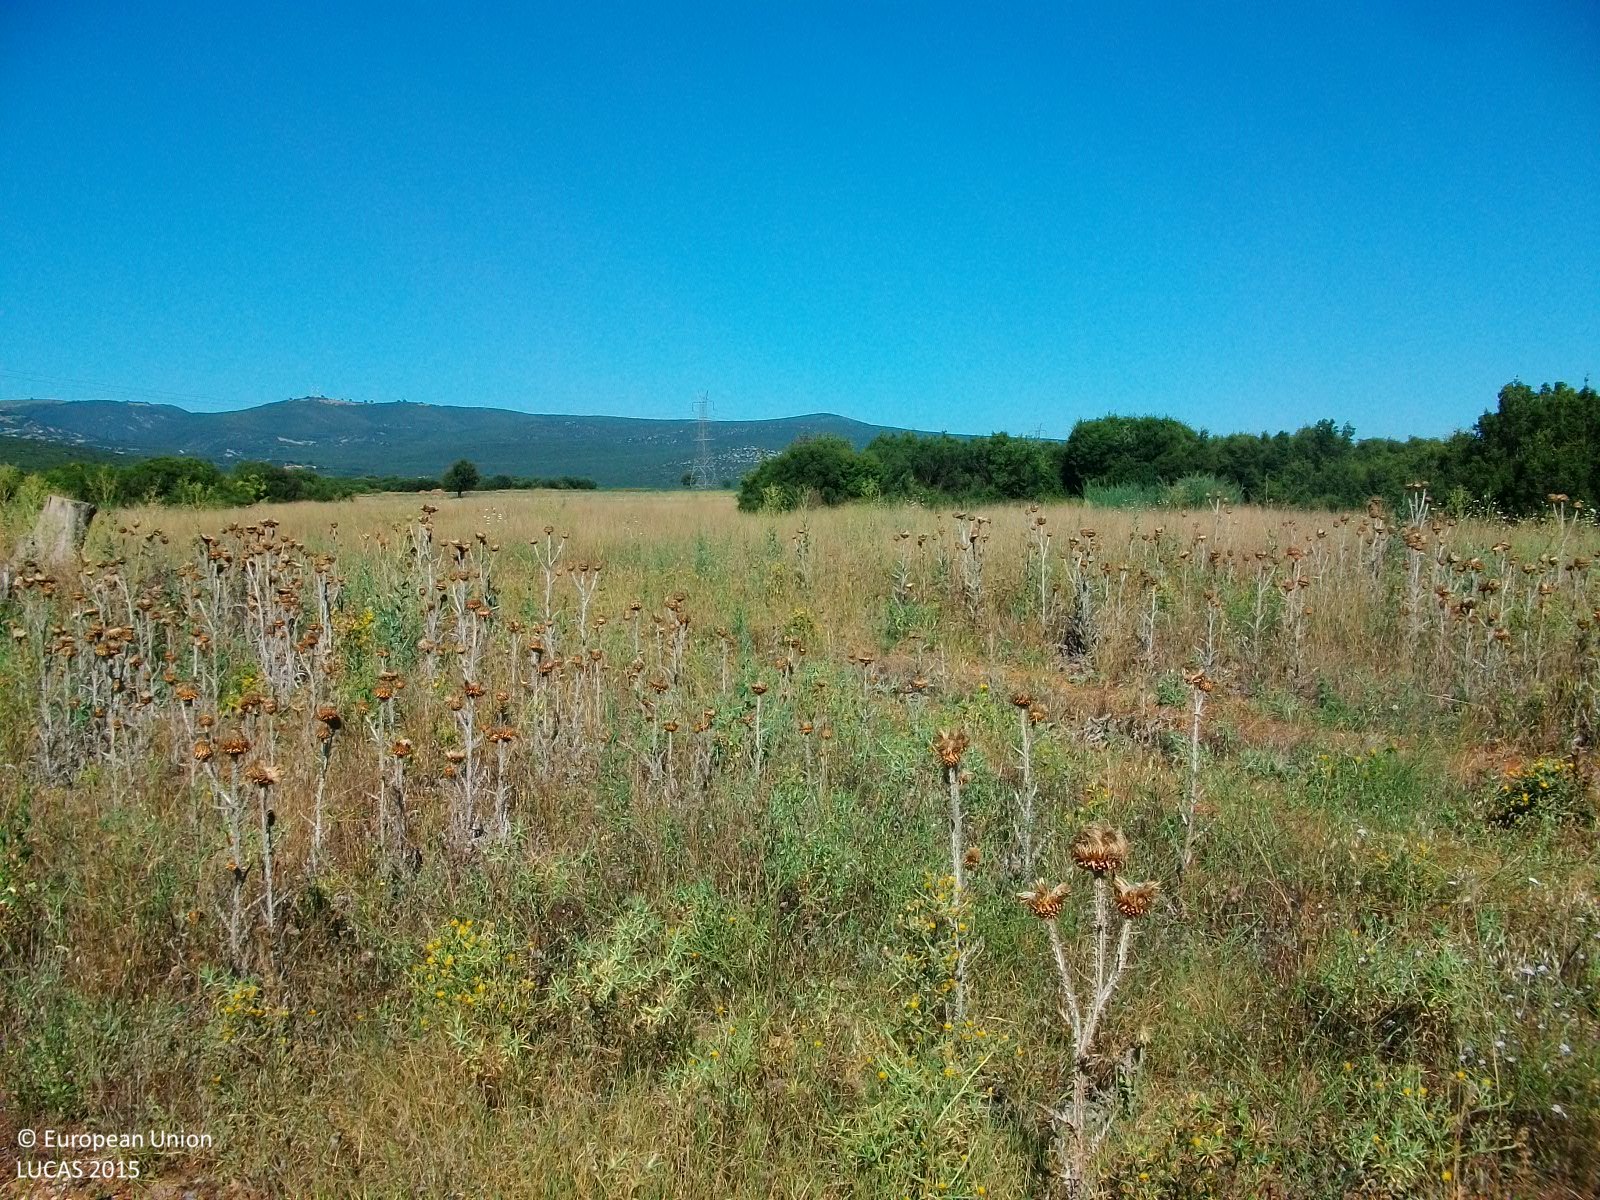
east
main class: Shrubland
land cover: Shrubland without tree cover
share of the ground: > 75 %
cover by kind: shrubs 90 %, herbaceous plants 10 %
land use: Semi-natural and natural areas not in use
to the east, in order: Shrubland without tree cover; Spontaneously vegetated surfaces; Shrubland without tree cover; Spontaneously vegetated surfaces; Durum wheat; Spontaneously vegetated surfaces
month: July
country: GR
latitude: 38.6664
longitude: 22.5867
